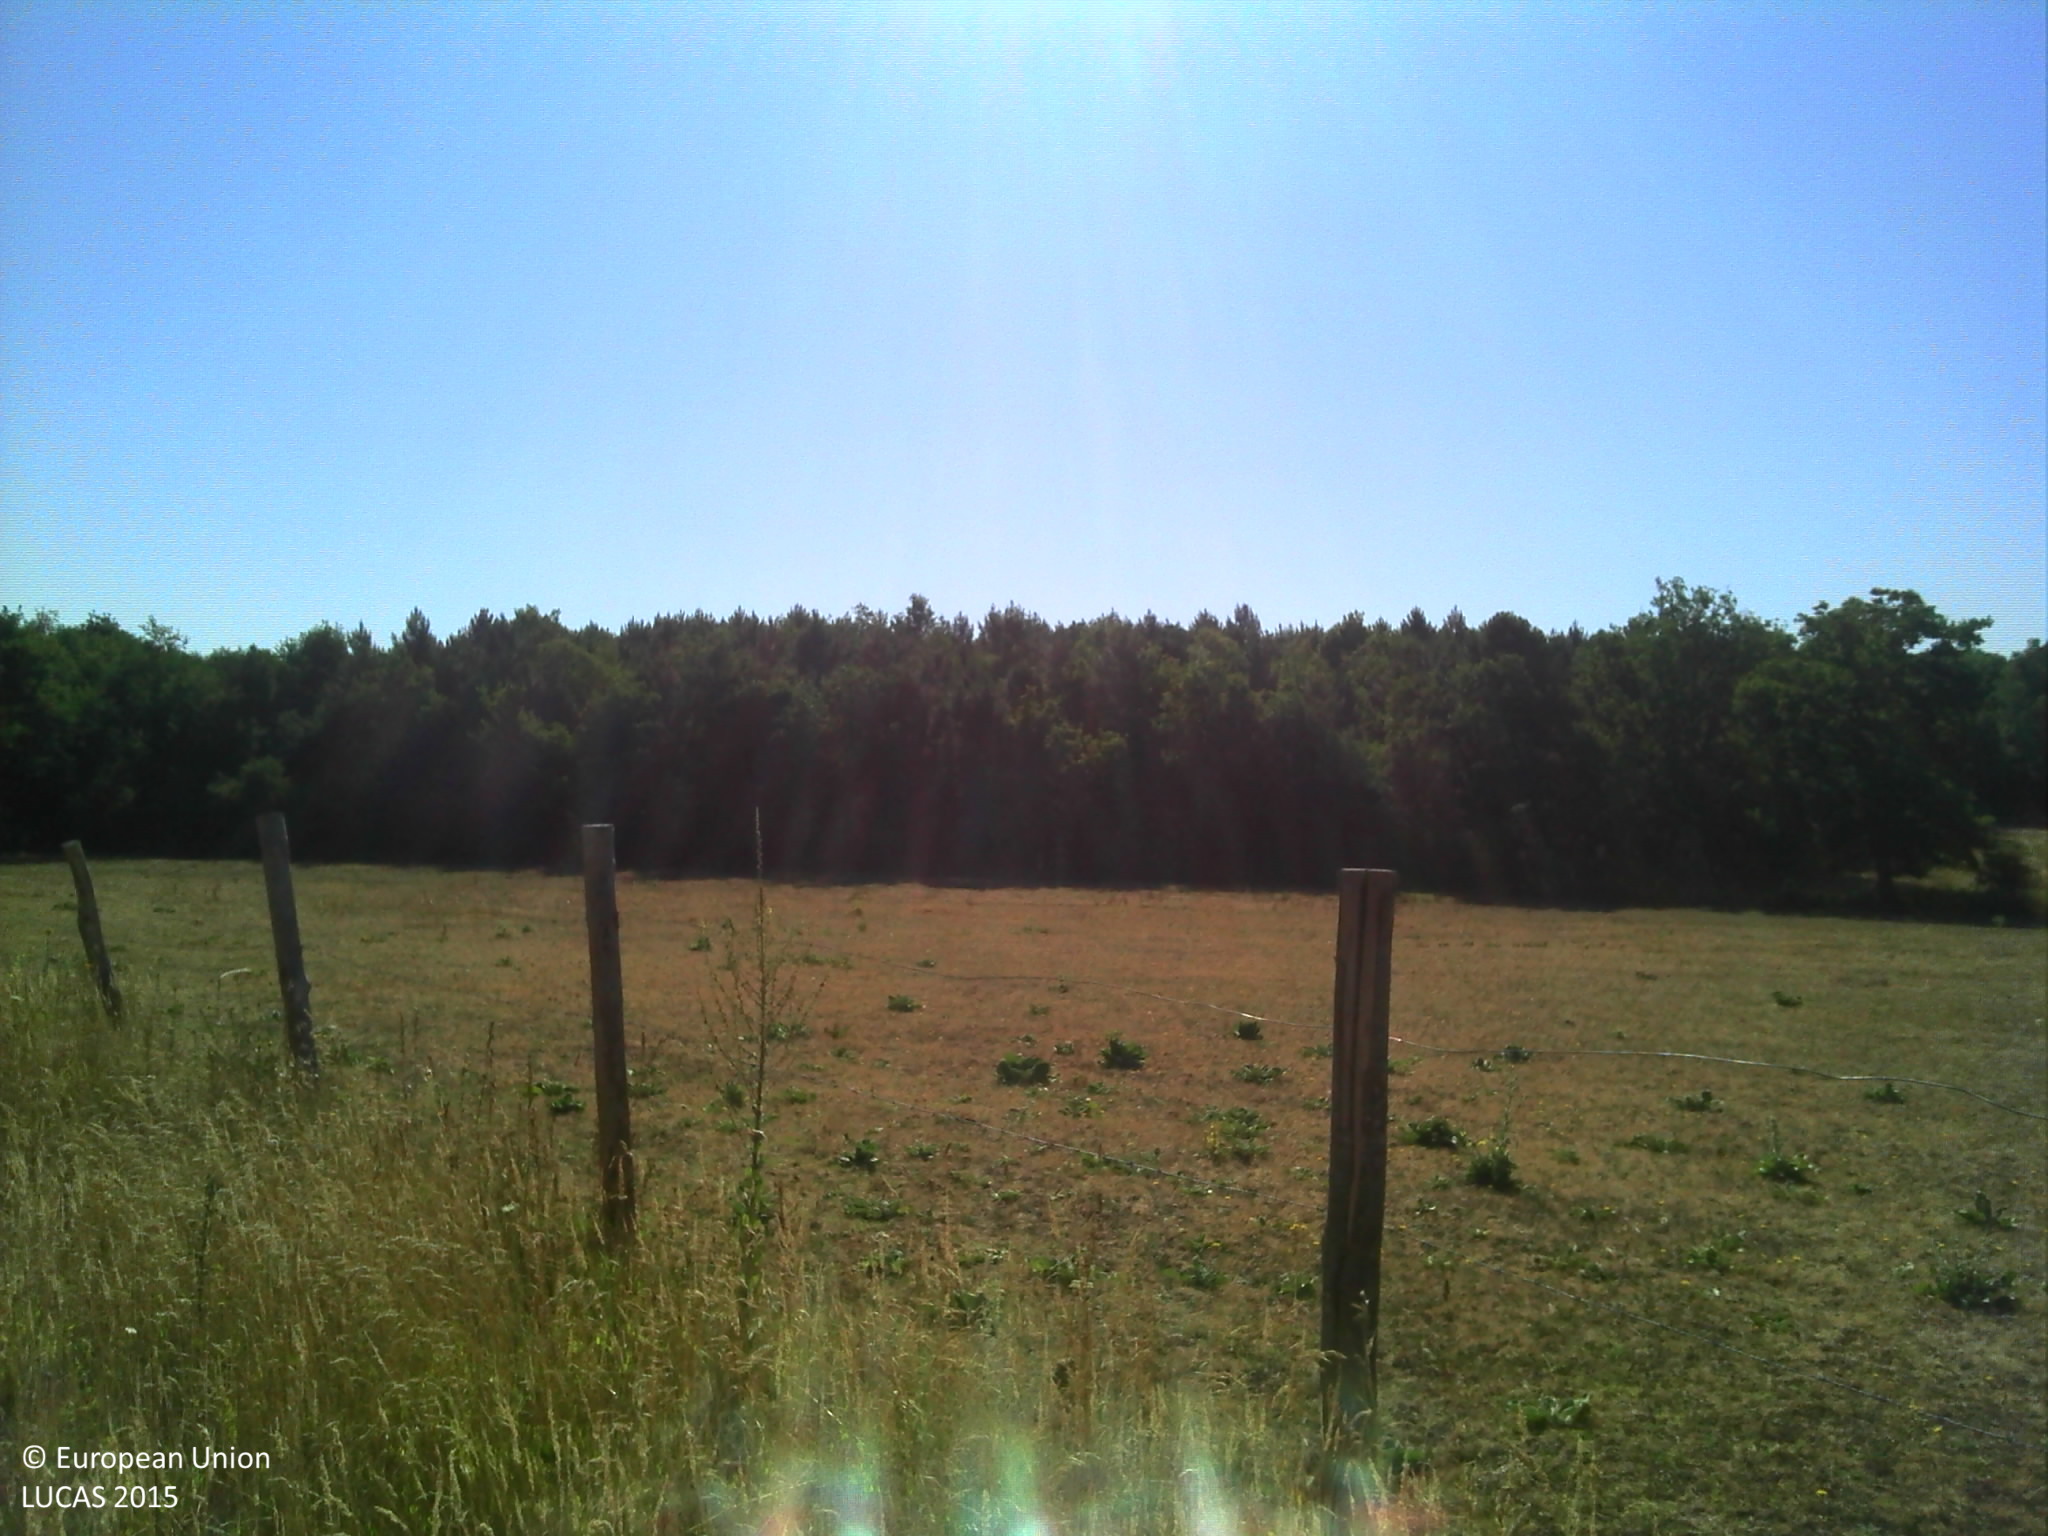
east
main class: Grassland
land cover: Grassland without tree/shrub cover
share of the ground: > 75 %
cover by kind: herbaceous plants 100 %
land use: Agriculture (excluding fallow land and kitchen gardens)
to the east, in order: Grassland without tree/shrub cover; Fences; Grassland without tree/shrub cover; Fences; Pine dominated mixed woodland
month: July
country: FR
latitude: 47.6473
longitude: 0.2712
